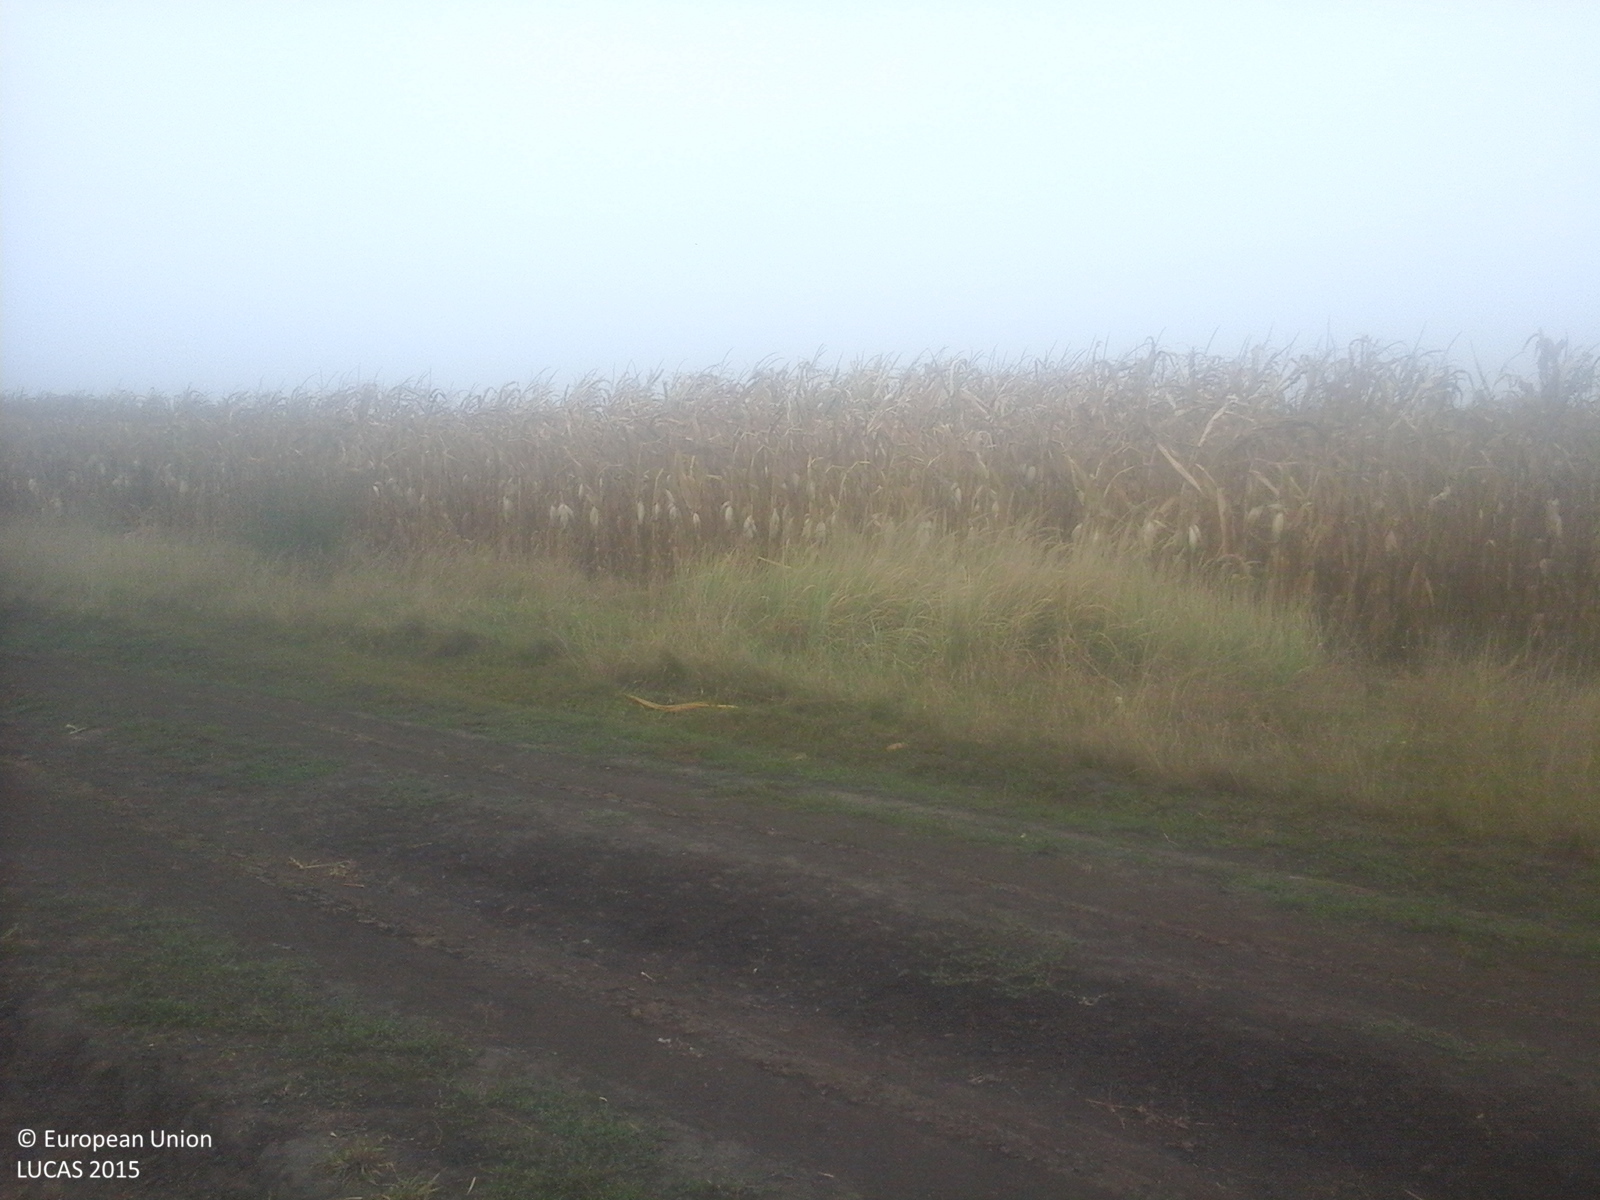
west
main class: Grassland
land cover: Grassland without tree/shrub cover
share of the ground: > 75 %
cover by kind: herbaceous plants 100 %
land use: Agriculture (excluding fallow land and kitchen gardens)
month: September
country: RO
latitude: 47.5003
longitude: 22.4150
